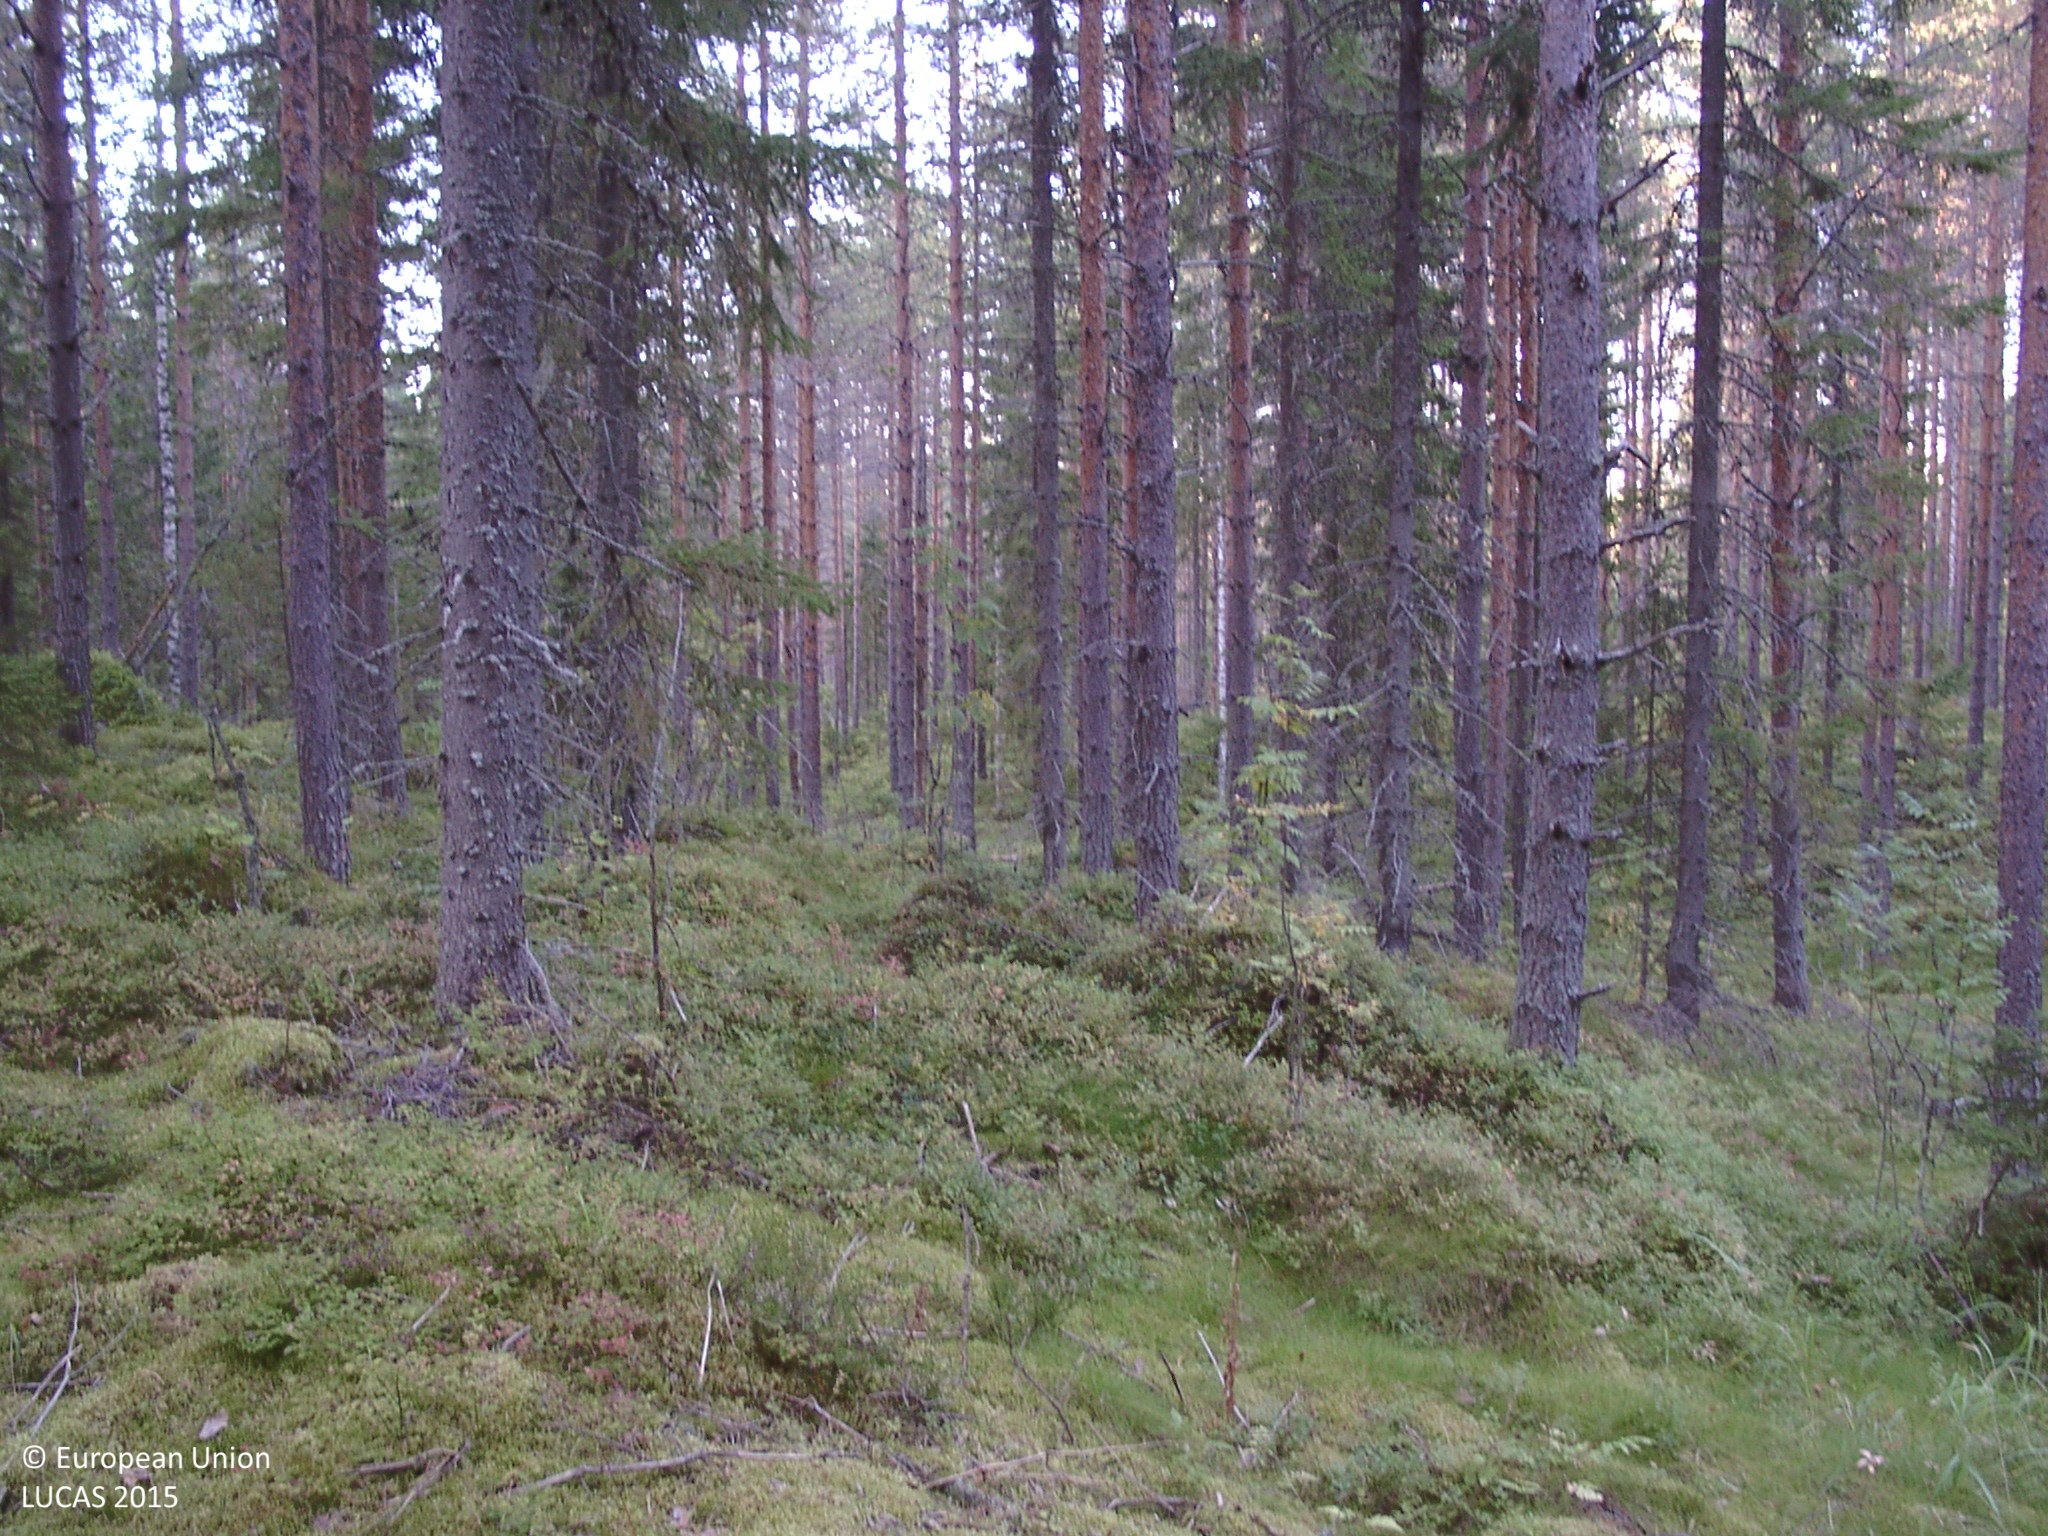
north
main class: Woodland
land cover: Other coniferous woodland
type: boreal forest
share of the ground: 50 - 75 %
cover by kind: coniferous forest trees 70 %, shrubs 15 %, lichens and mosses 10 %, herbaceous plants 5 %
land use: Forestry
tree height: > 5 m
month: September
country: FI
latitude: 62.4636
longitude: 25.5270
